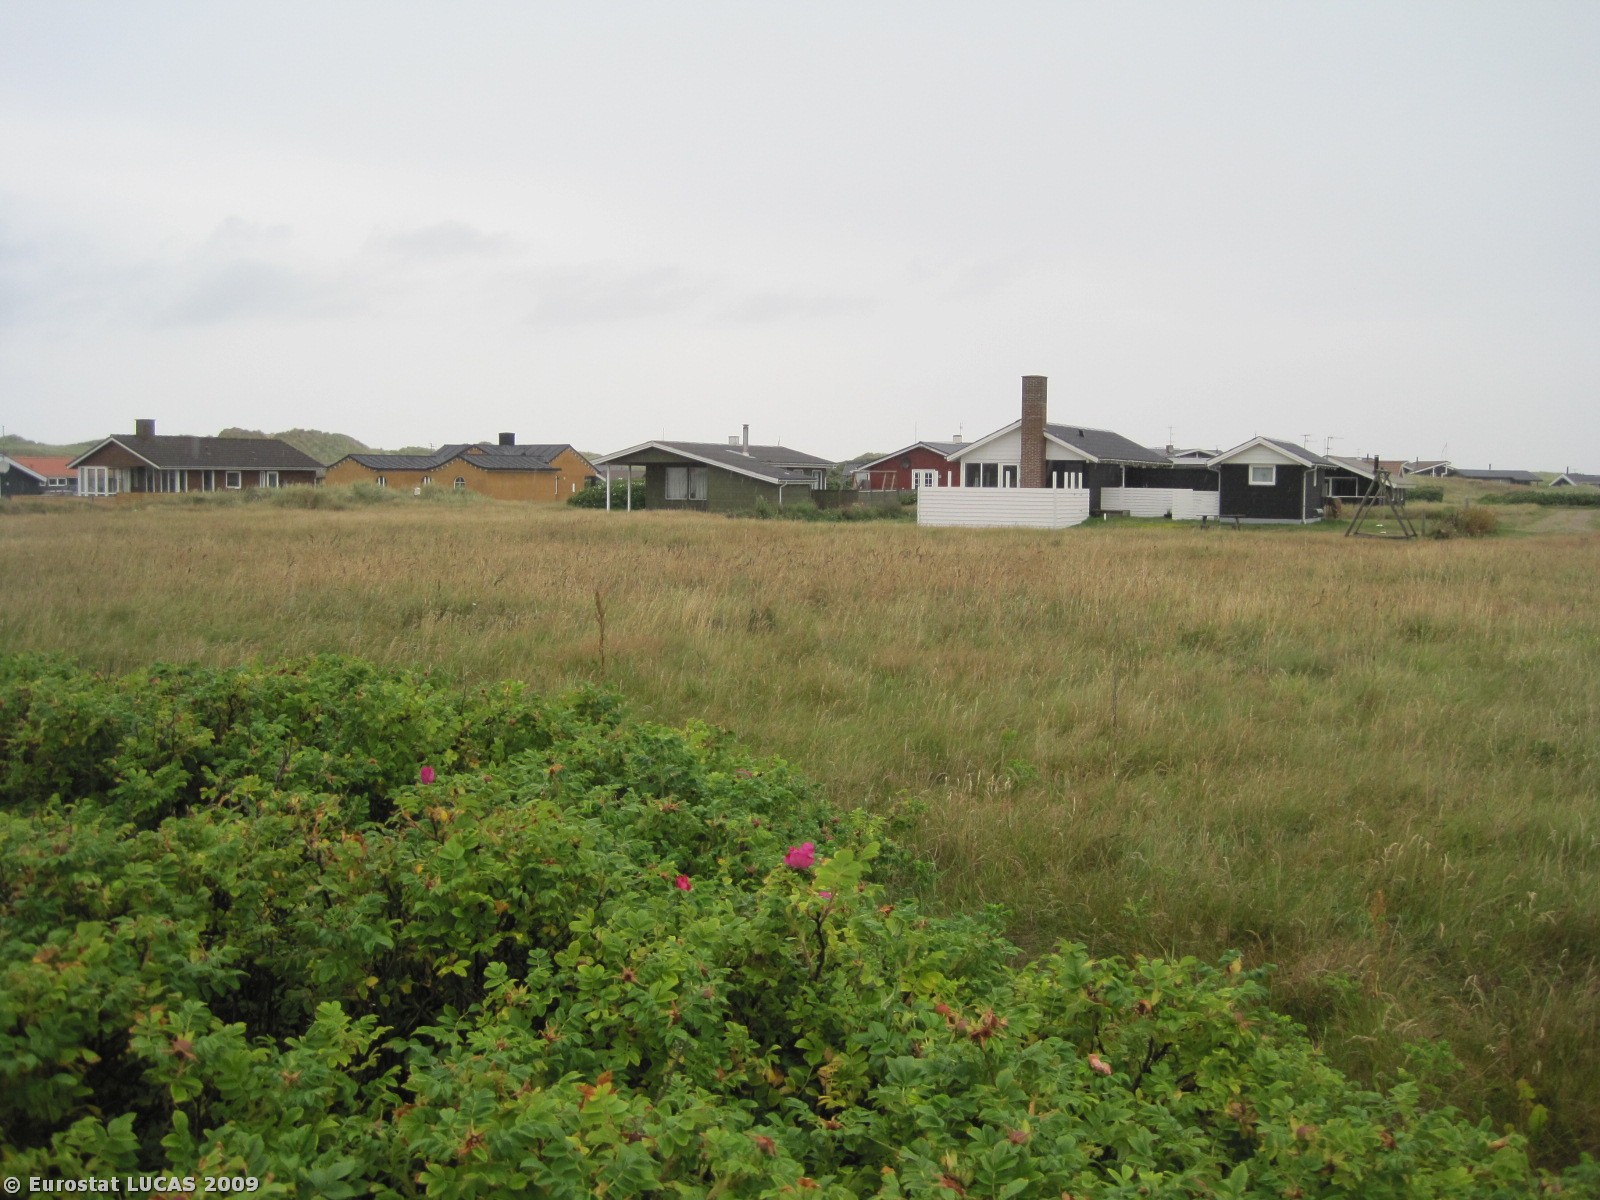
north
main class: Grassland
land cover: Grassland without tree/shrub cover
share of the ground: > 75 %
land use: Amenities, museums, leisure
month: July
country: DK
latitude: 57.0421
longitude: 8.5024
